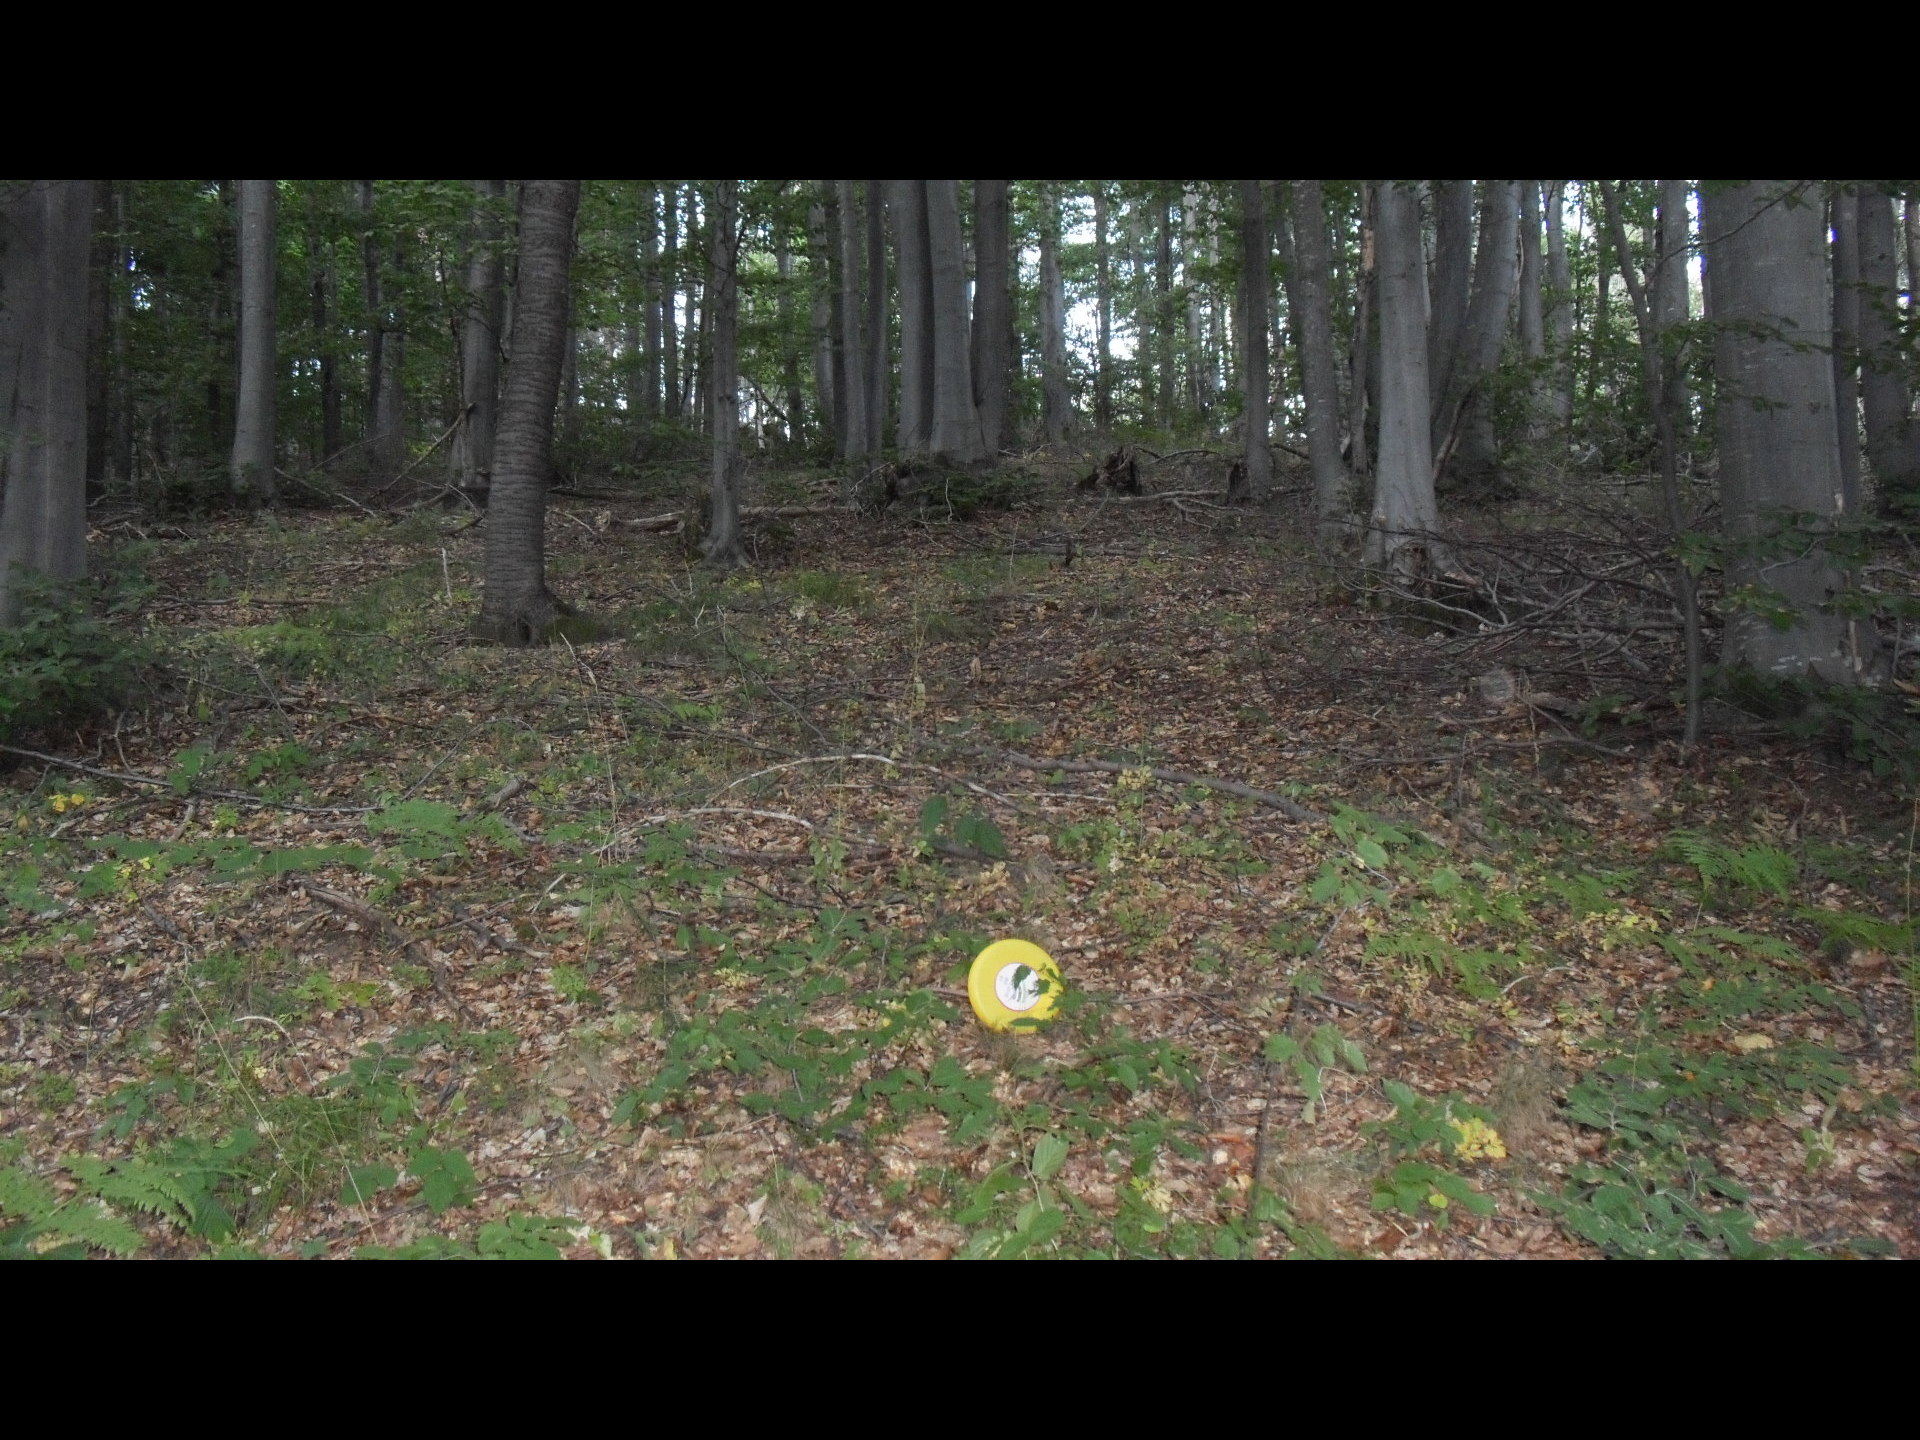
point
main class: Woodland
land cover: Broadleaved woodland
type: beech forest
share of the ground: > 75 %
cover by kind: broadleaved forest trees 95 %, unconsolidated bare surface 5 %
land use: Forestry
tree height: > 5 m
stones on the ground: < 10 %
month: August
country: BG
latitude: 43.2450
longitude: 23.0784
